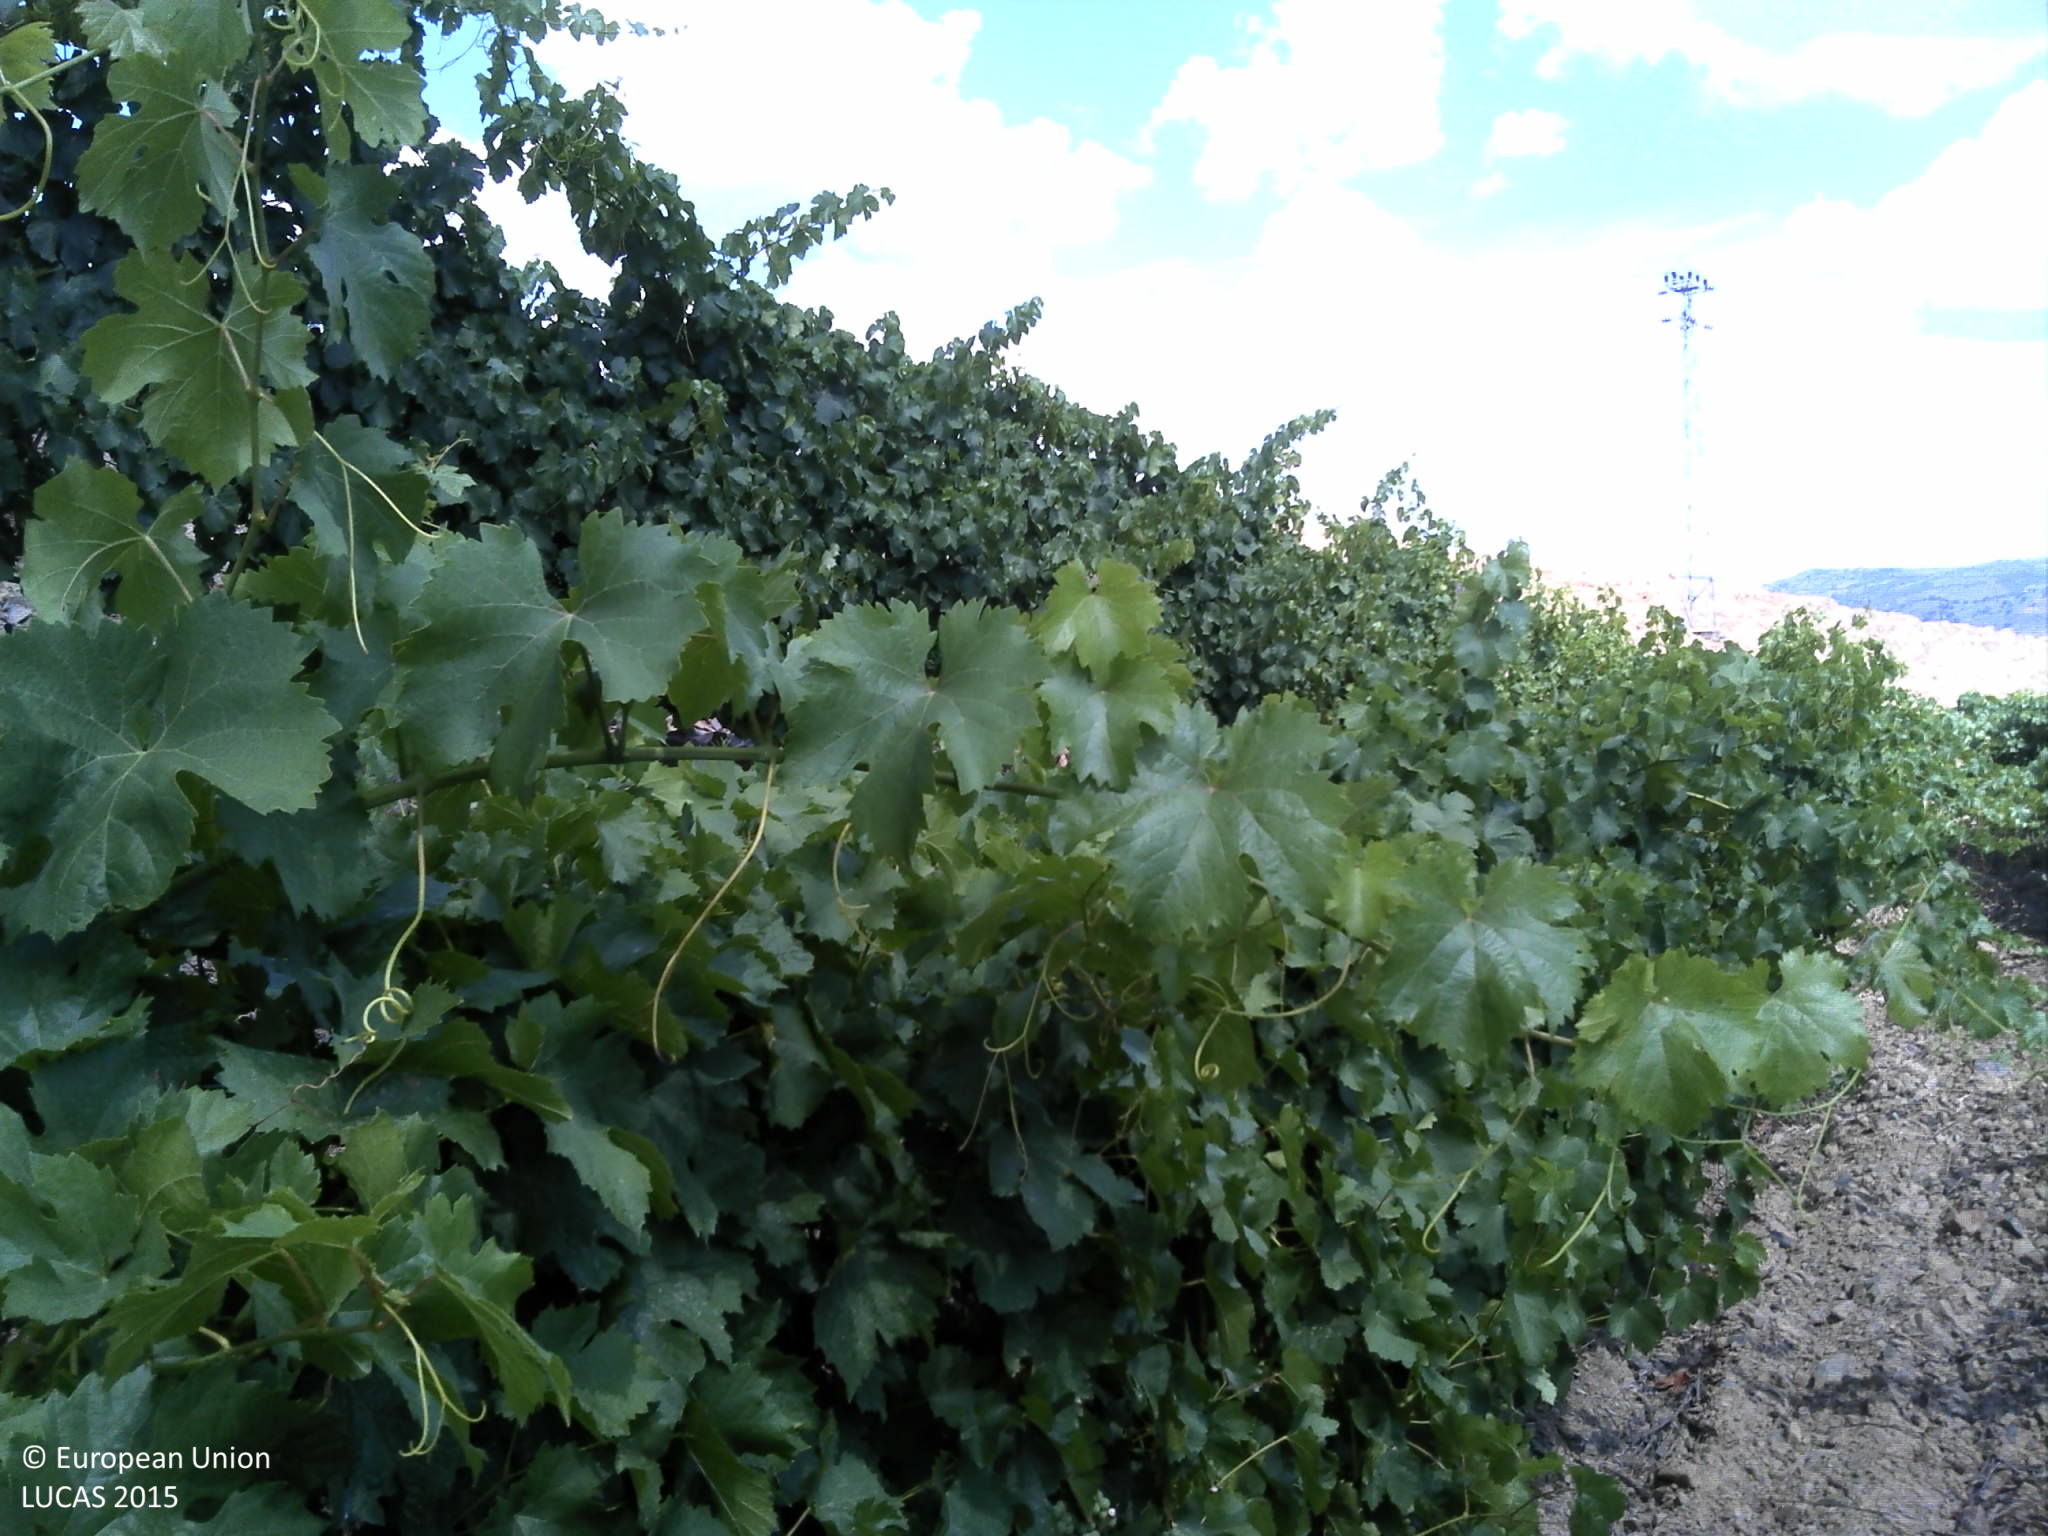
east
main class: Cropland
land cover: Vineyards
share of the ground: 10 - 25 %
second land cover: Other bare soil
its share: > 75 %
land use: Agriculture (excluding fallow land and kitchen gardens)
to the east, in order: Vineyards; Other bare soil; Vineyards; Tracks; Other bare soil; Electric lines; Other bare soil; Tracks; Other bare soil; Electric lines; Other bare soil; Tracks; Shrubland with sparse tree cover
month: June
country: PT
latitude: 41.0690
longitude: -6.8245
